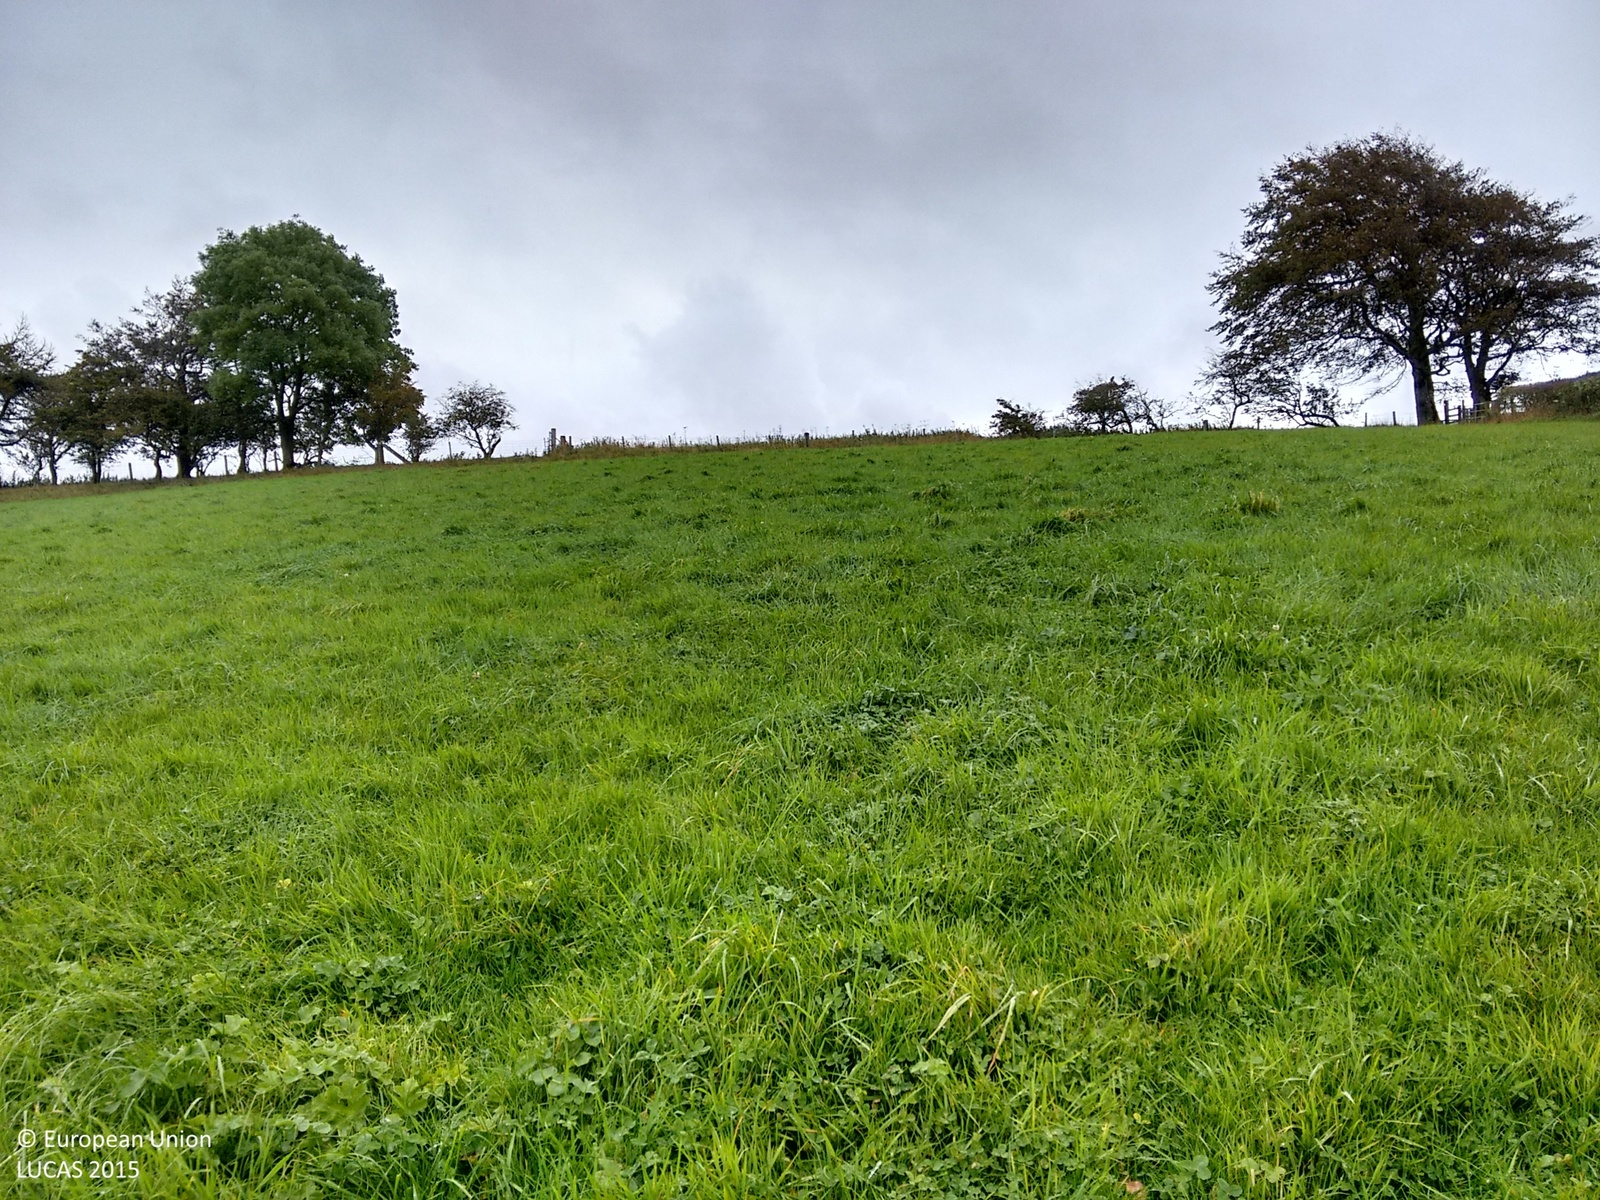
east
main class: Grassland
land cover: Grassland without tree/shrub cover
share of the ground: > 75 %
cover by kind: herbaceous plants 100 %
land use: Agriculture (excluding fallow land and kitchen gardens)
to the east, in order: Grassland without tree/shrub cover; Fences; Grassland without tree/shrub cover; Other root crops
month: October
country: GB
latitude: 52.4527
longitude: -3.0696
